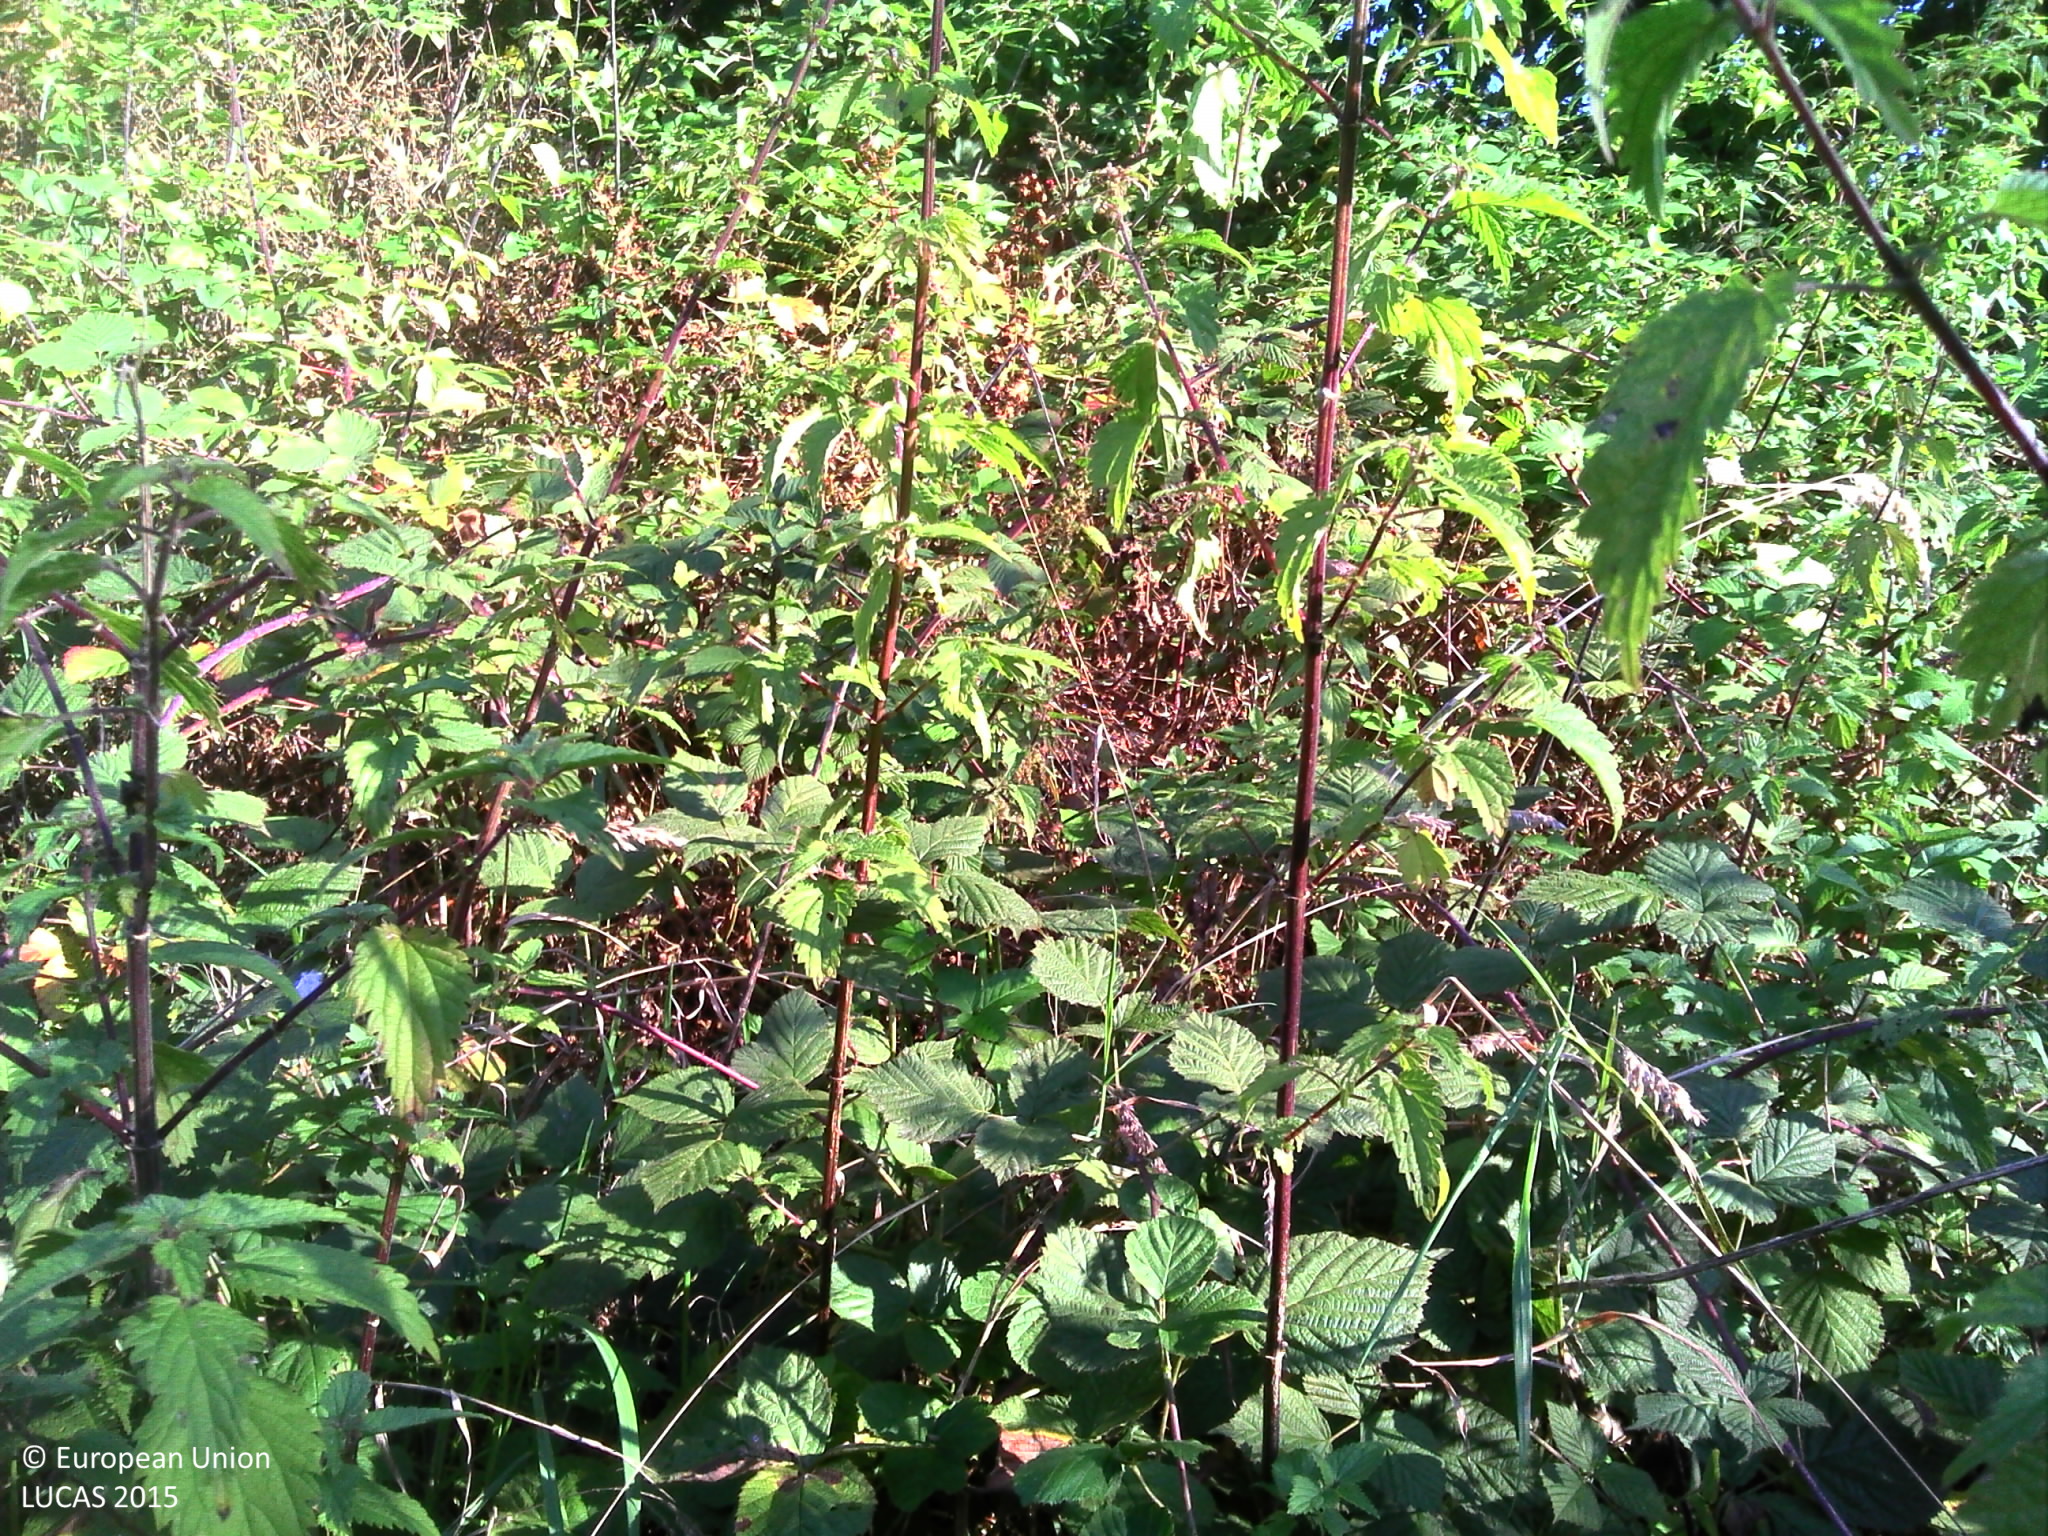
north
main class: Cropland
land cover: Apple fruit
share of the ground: > 75 %
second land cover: Grassland without tree/shrub cover
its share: > 75 %
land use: Agriculture (excluding fallow land and kitchen gardens)
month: September
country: BE
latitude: 51.1943
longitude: 4.6587
